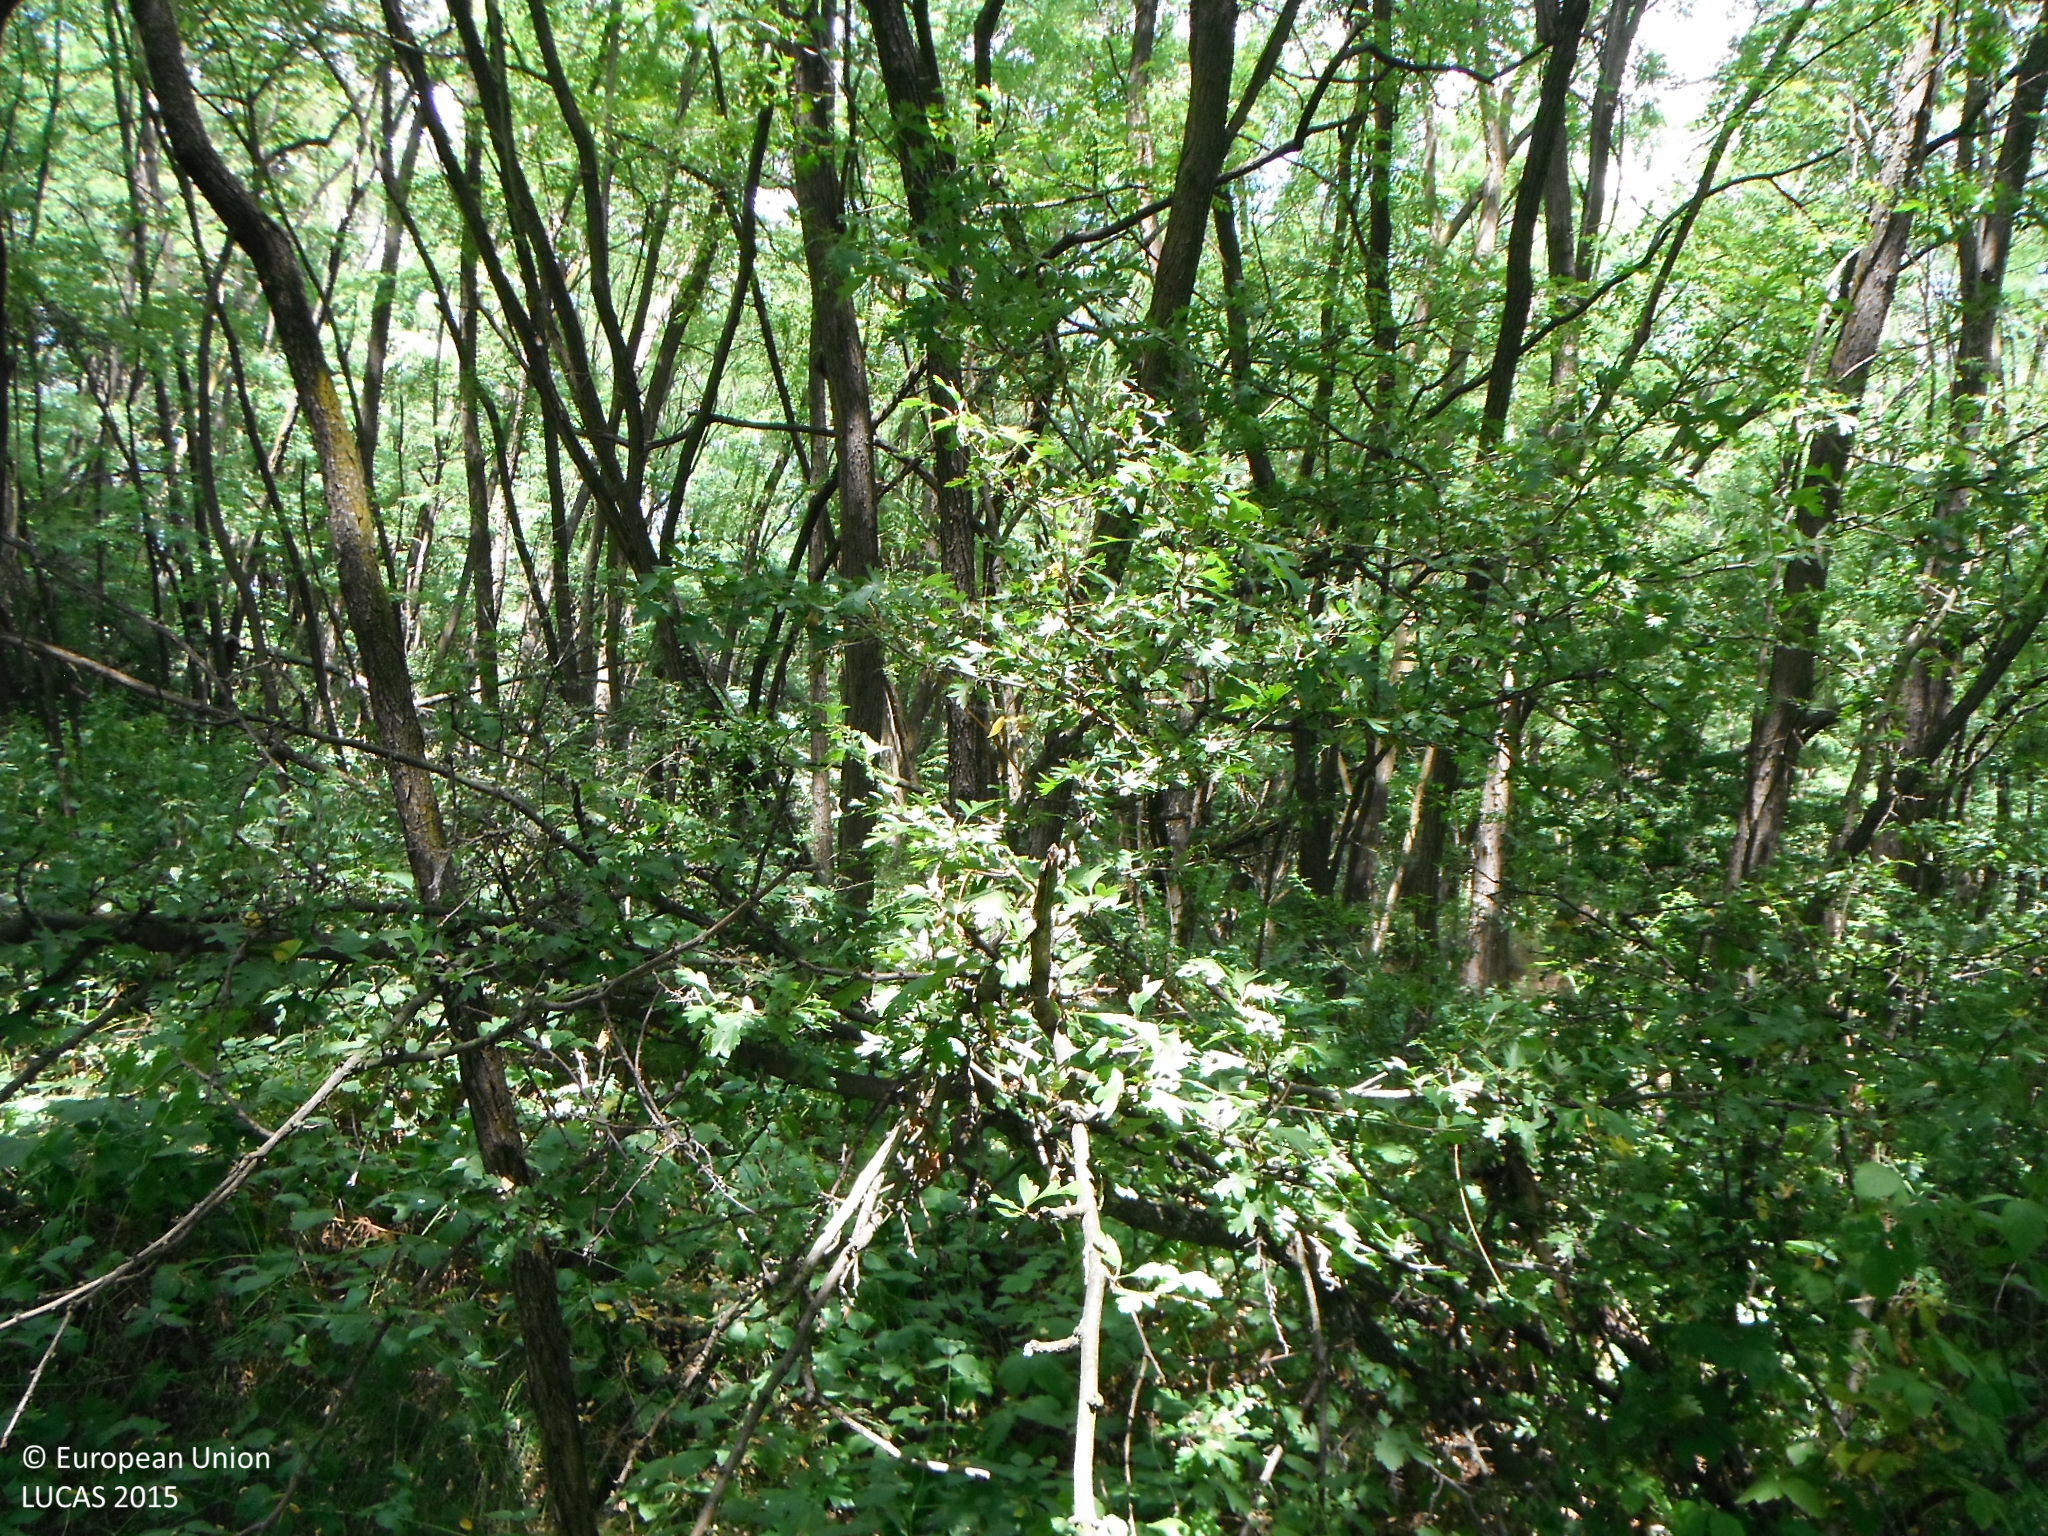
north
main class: Woodland
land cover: Broadleaved woodland
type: mesophytic deciduous forest
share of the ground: > 75 %
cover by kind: broadleaved forest trees 100 %
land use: Forestry
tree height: > 5 m
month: July
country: SK
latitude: 48.2596
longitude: 19.1404
